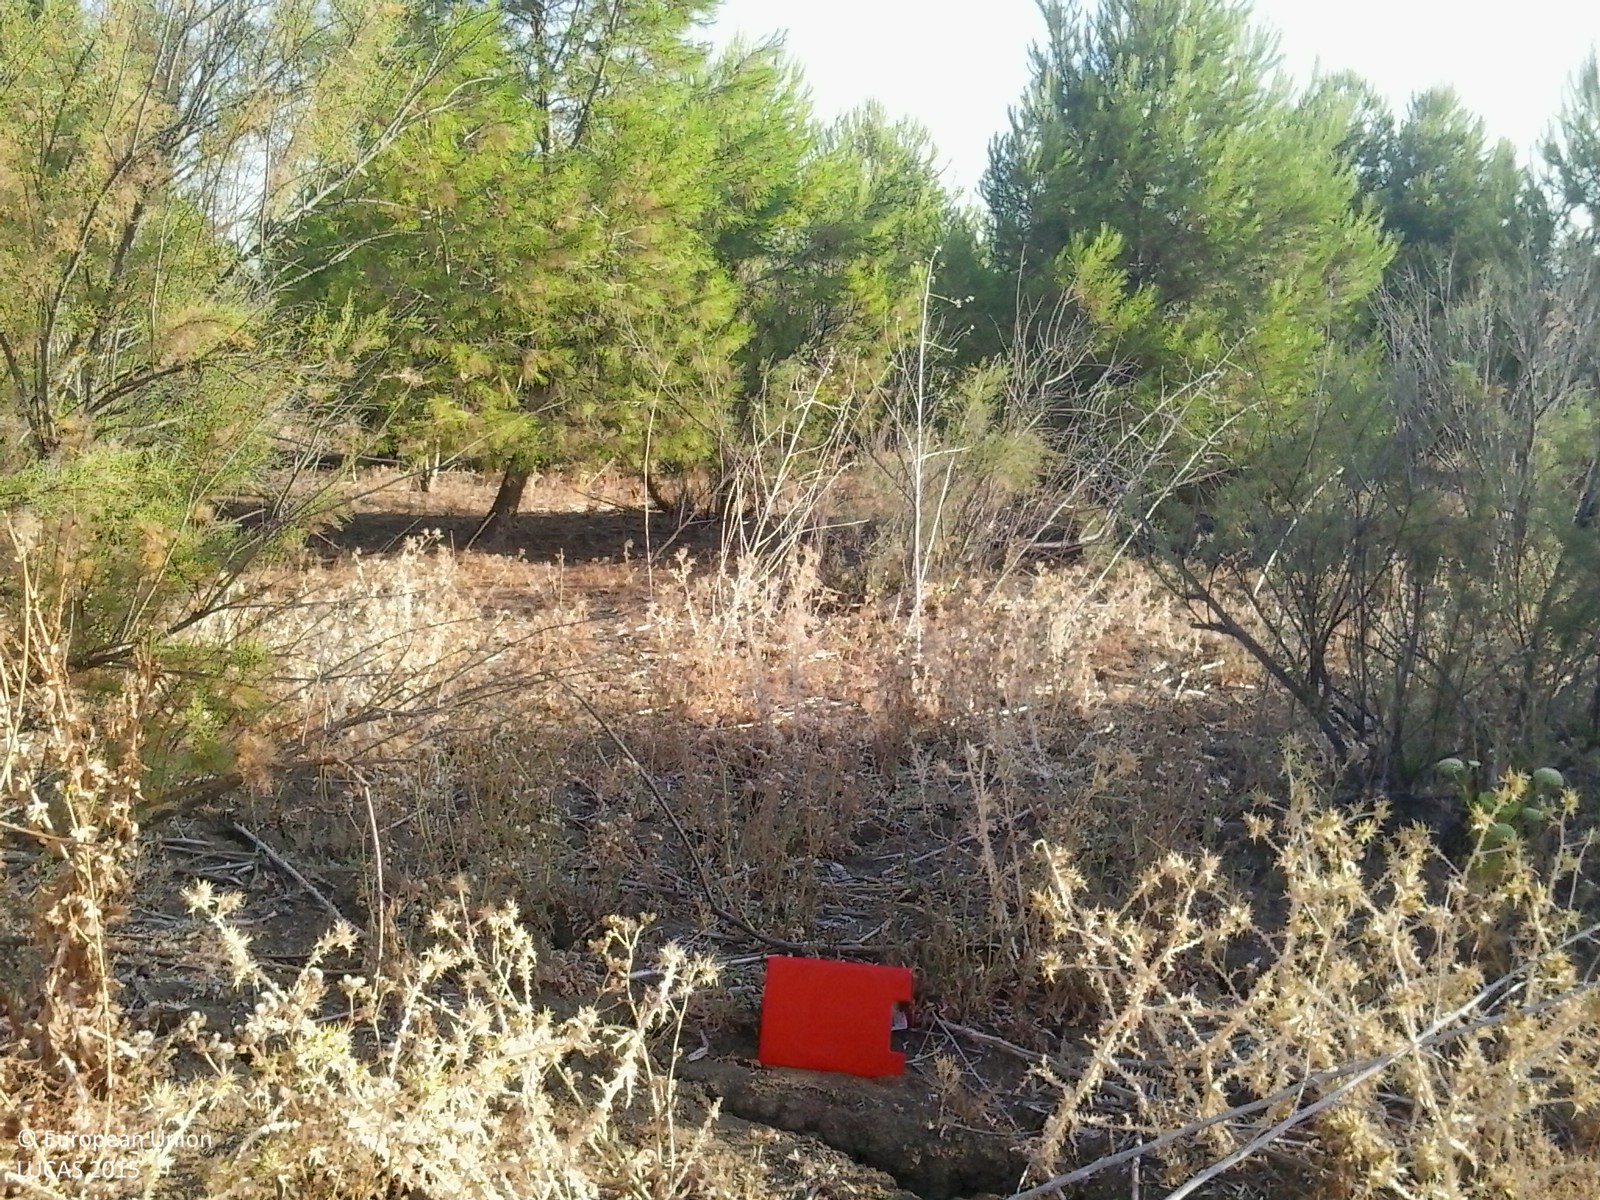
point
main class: Woodland
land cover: Pine dominated coniferous woodland
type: coniferous forest of the mediterranean region
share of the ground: 25 - 50 %
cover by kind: shrubs 50 %, coniferous forest trees 30 %, herbaceous plants 20 %
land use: Forestry
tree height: > 5 m
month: July
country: ES
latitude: 36.9481
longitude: -6.0403
